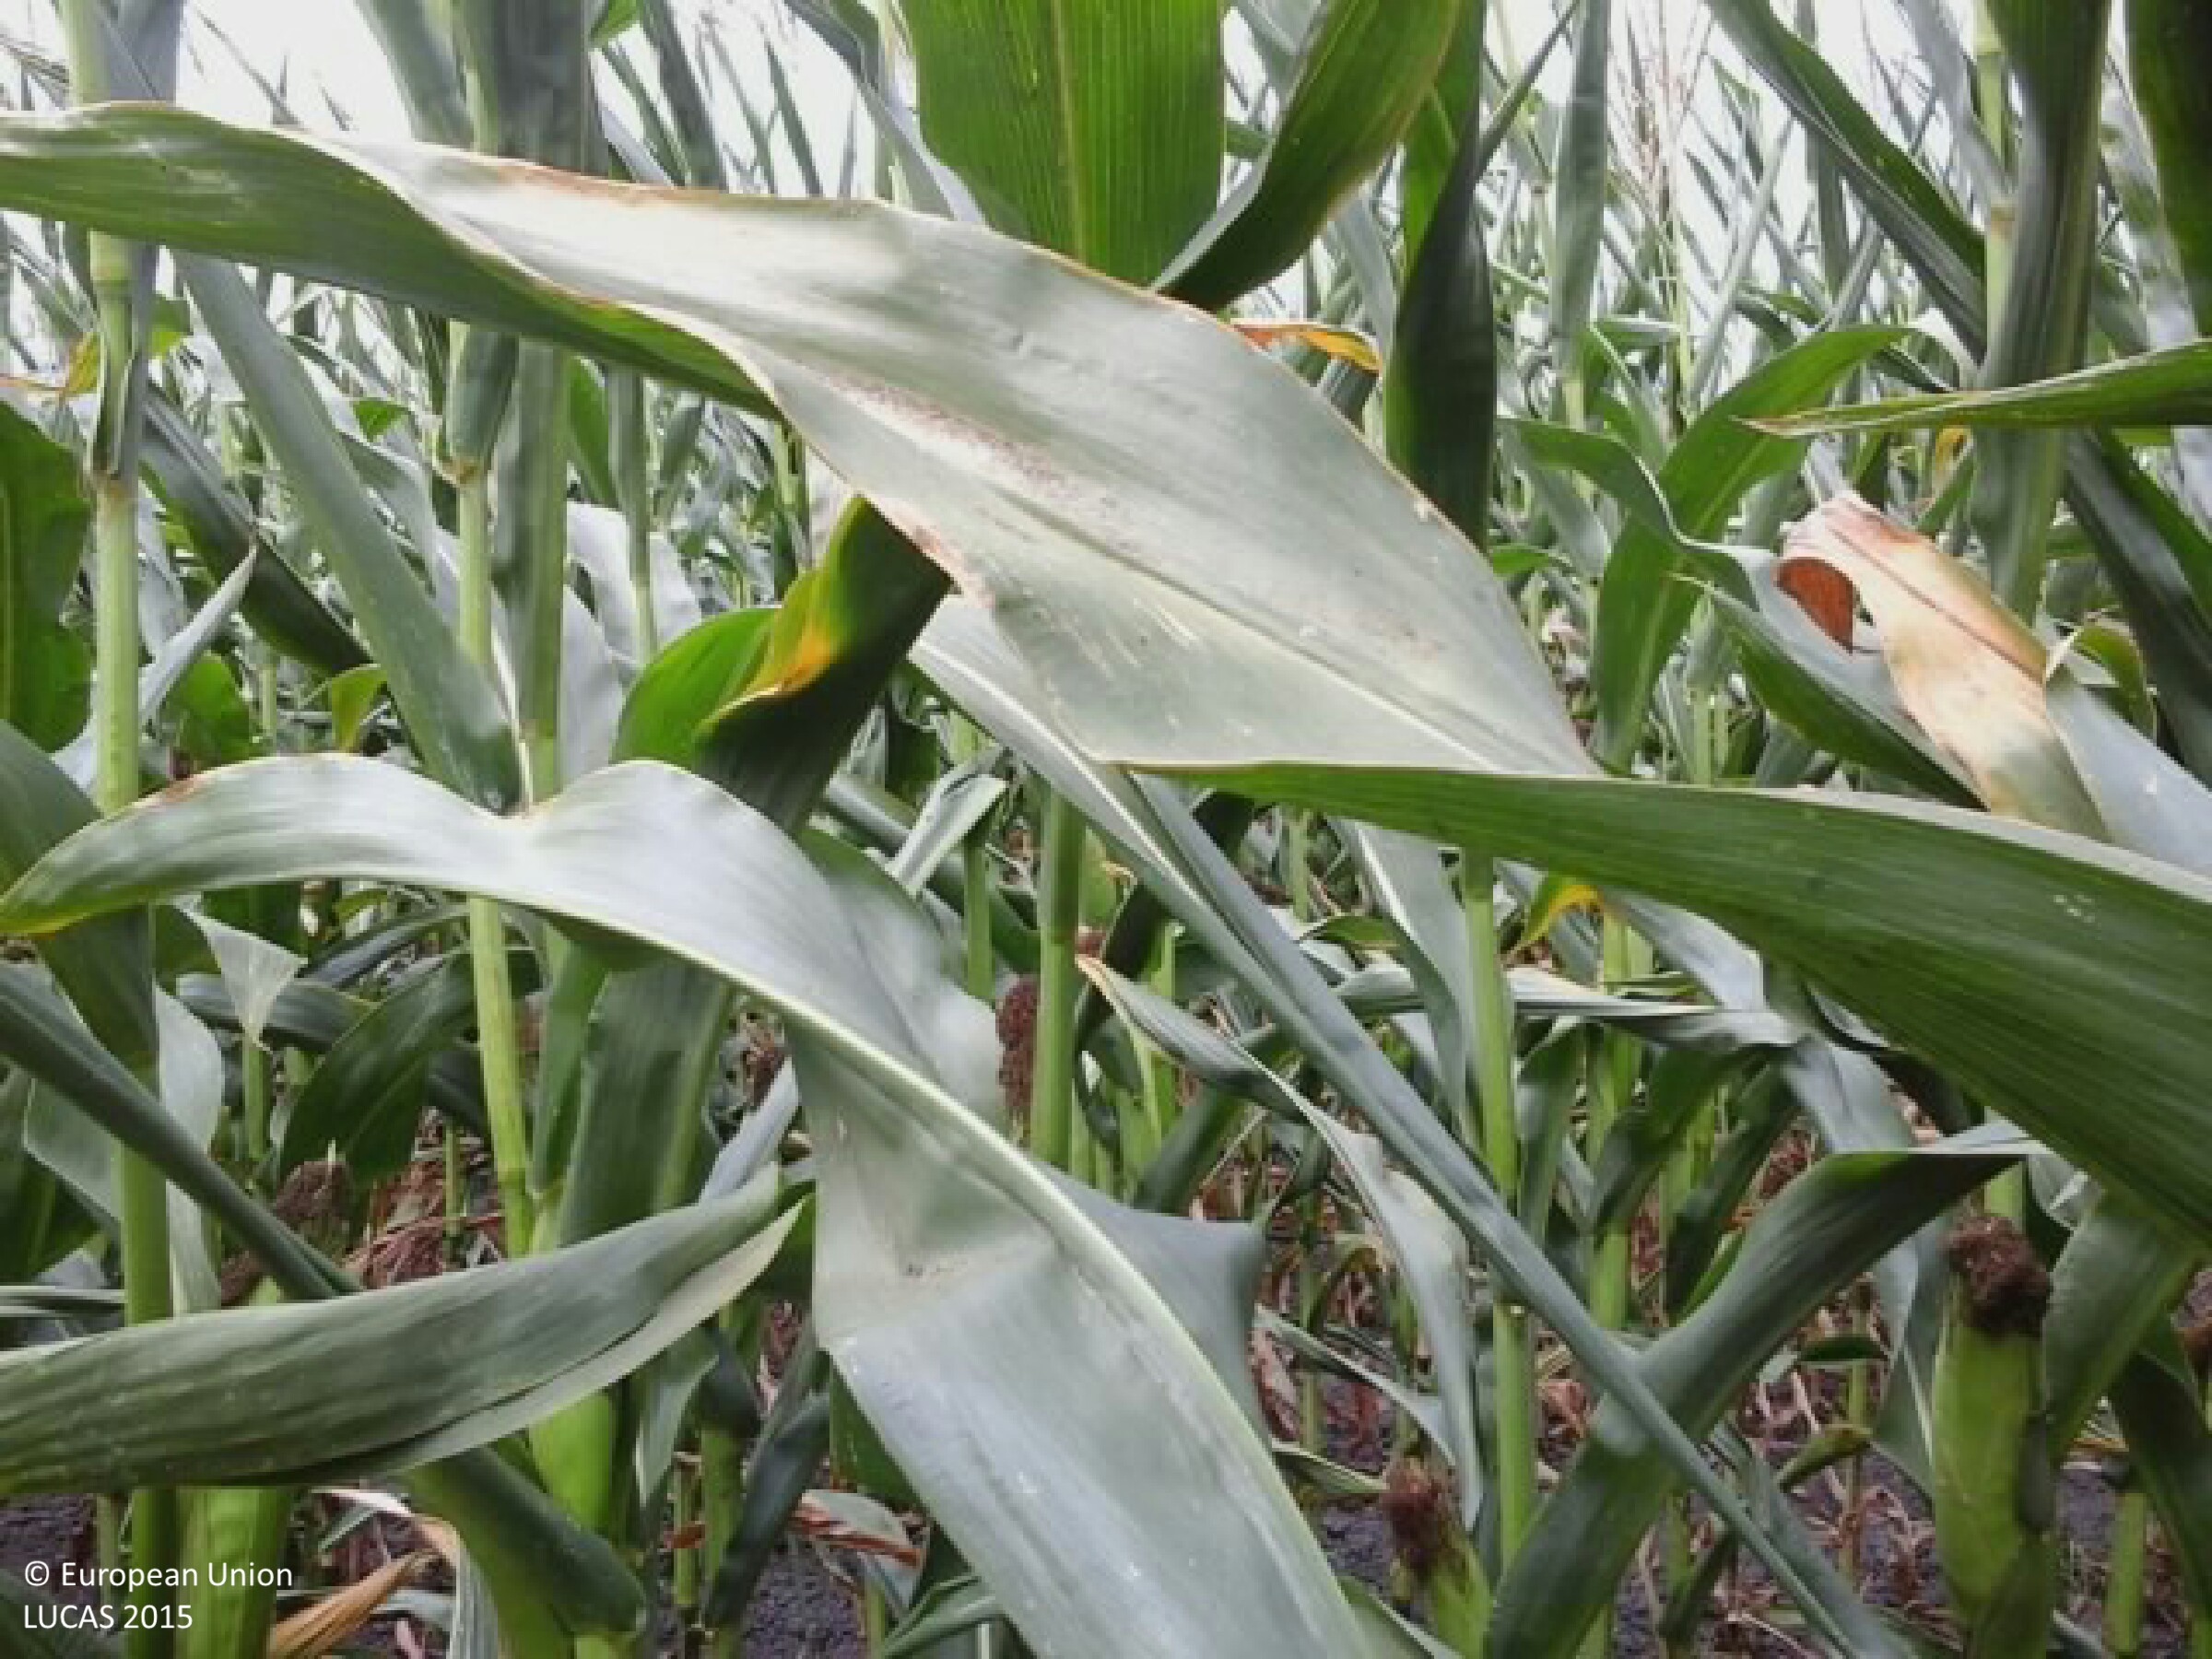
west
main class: Cropland
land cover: Maize
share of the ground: > 75 %
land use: Agriculture (excluding fallow land and kitchen gardens)
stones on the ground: < 10 %
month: July
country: HU
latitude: 46.2223
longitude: 18.8141
